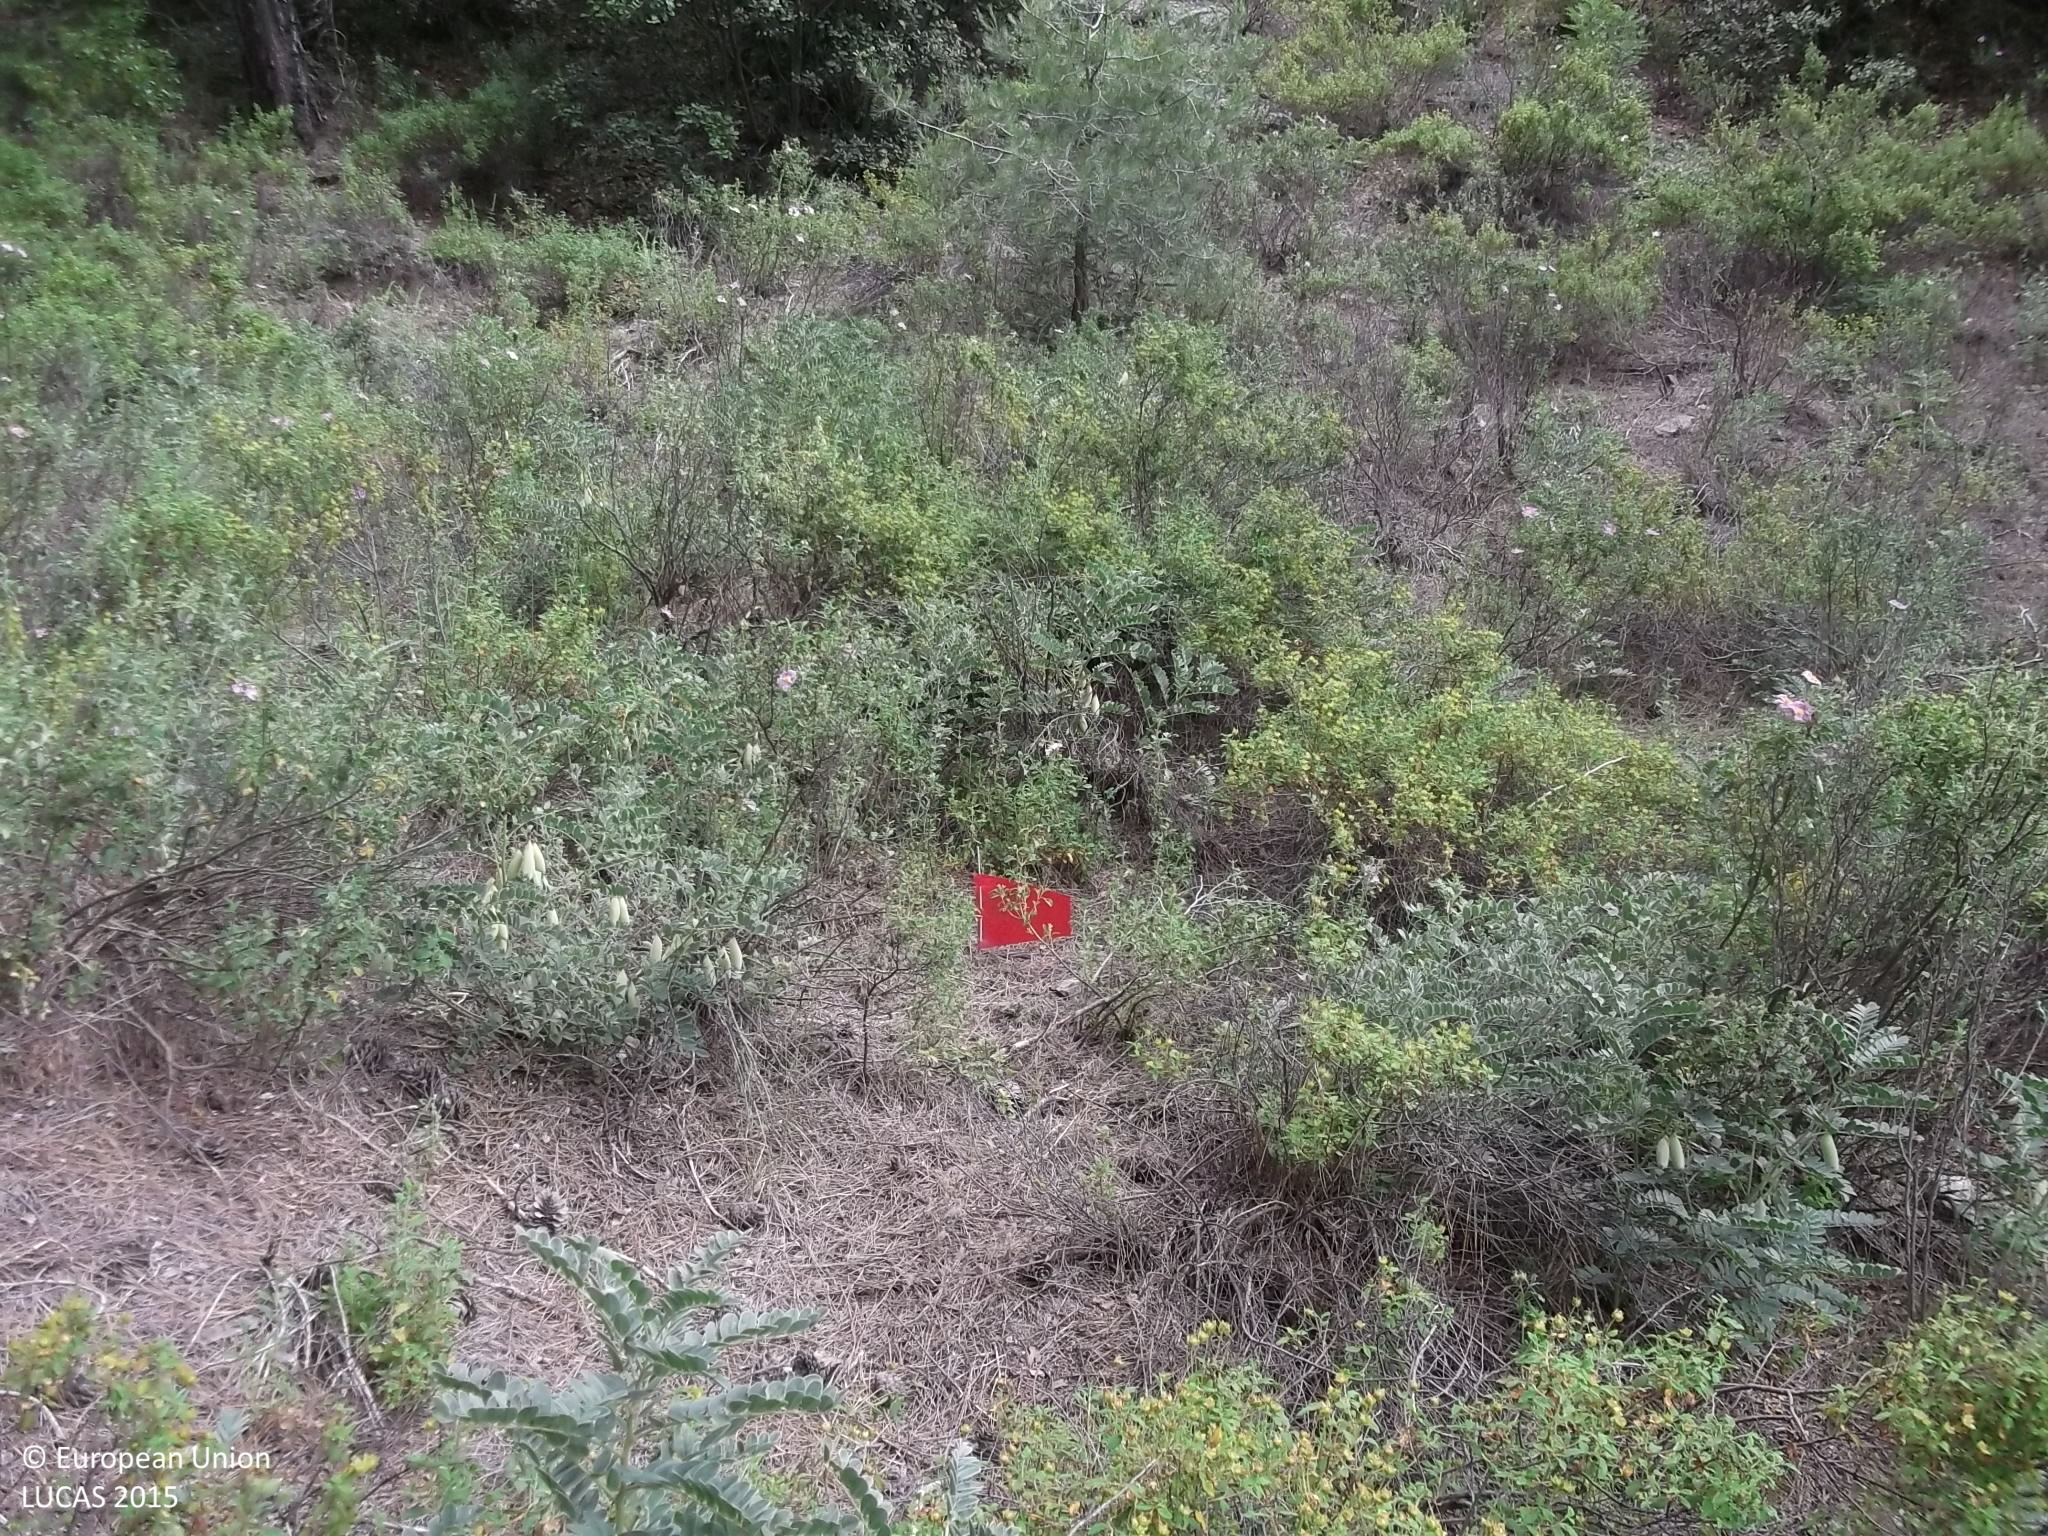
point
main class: Woodland
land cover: Pine dominated coniferous woodland
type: coniferous forest of the mediterranean region
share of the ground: > 75 %
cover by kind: coniferous forest trees 80 %, shrubs 15 %, unconsolidated bare surface 5 %
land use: Semi-natural and natural areas not in use
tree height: > 5 m
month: June
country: CY
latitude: 34.9198
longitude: 32.9480
